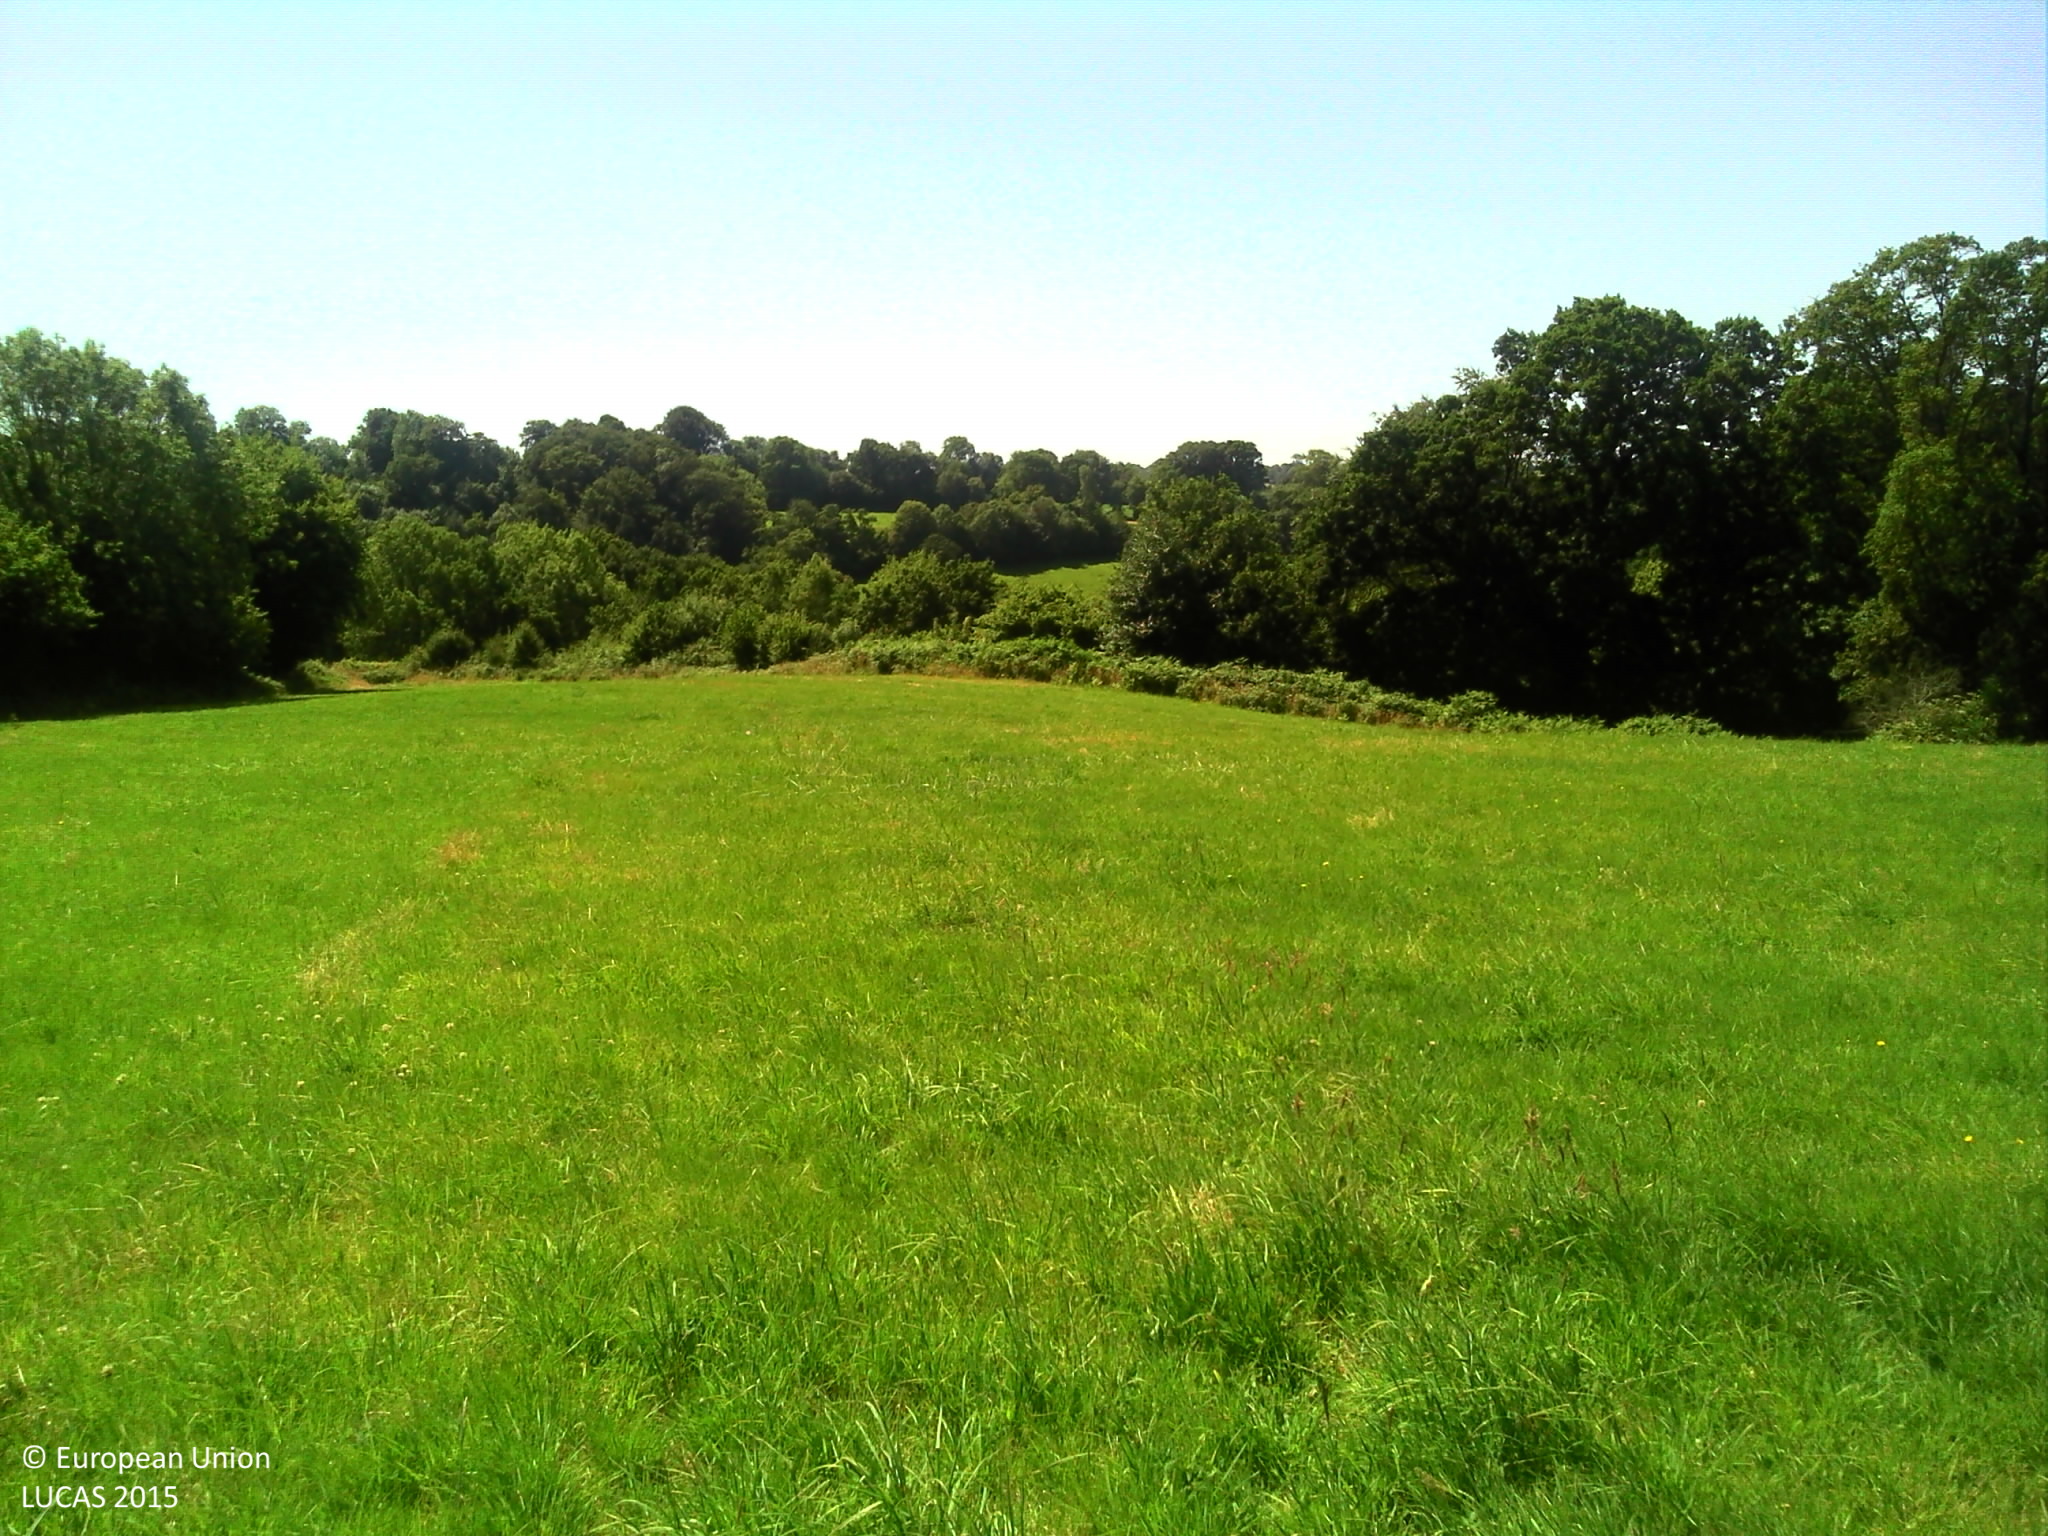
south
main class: Grassland
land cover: Grassland without tree/shrub cover
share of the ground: > 75 %
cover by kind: herbaceous plants 100 %
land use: Agriculture (excluding fallow land and kitchen gardens)
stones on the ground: < 10 %
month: July
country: FR
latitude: 49.0455
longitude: -1.4166
